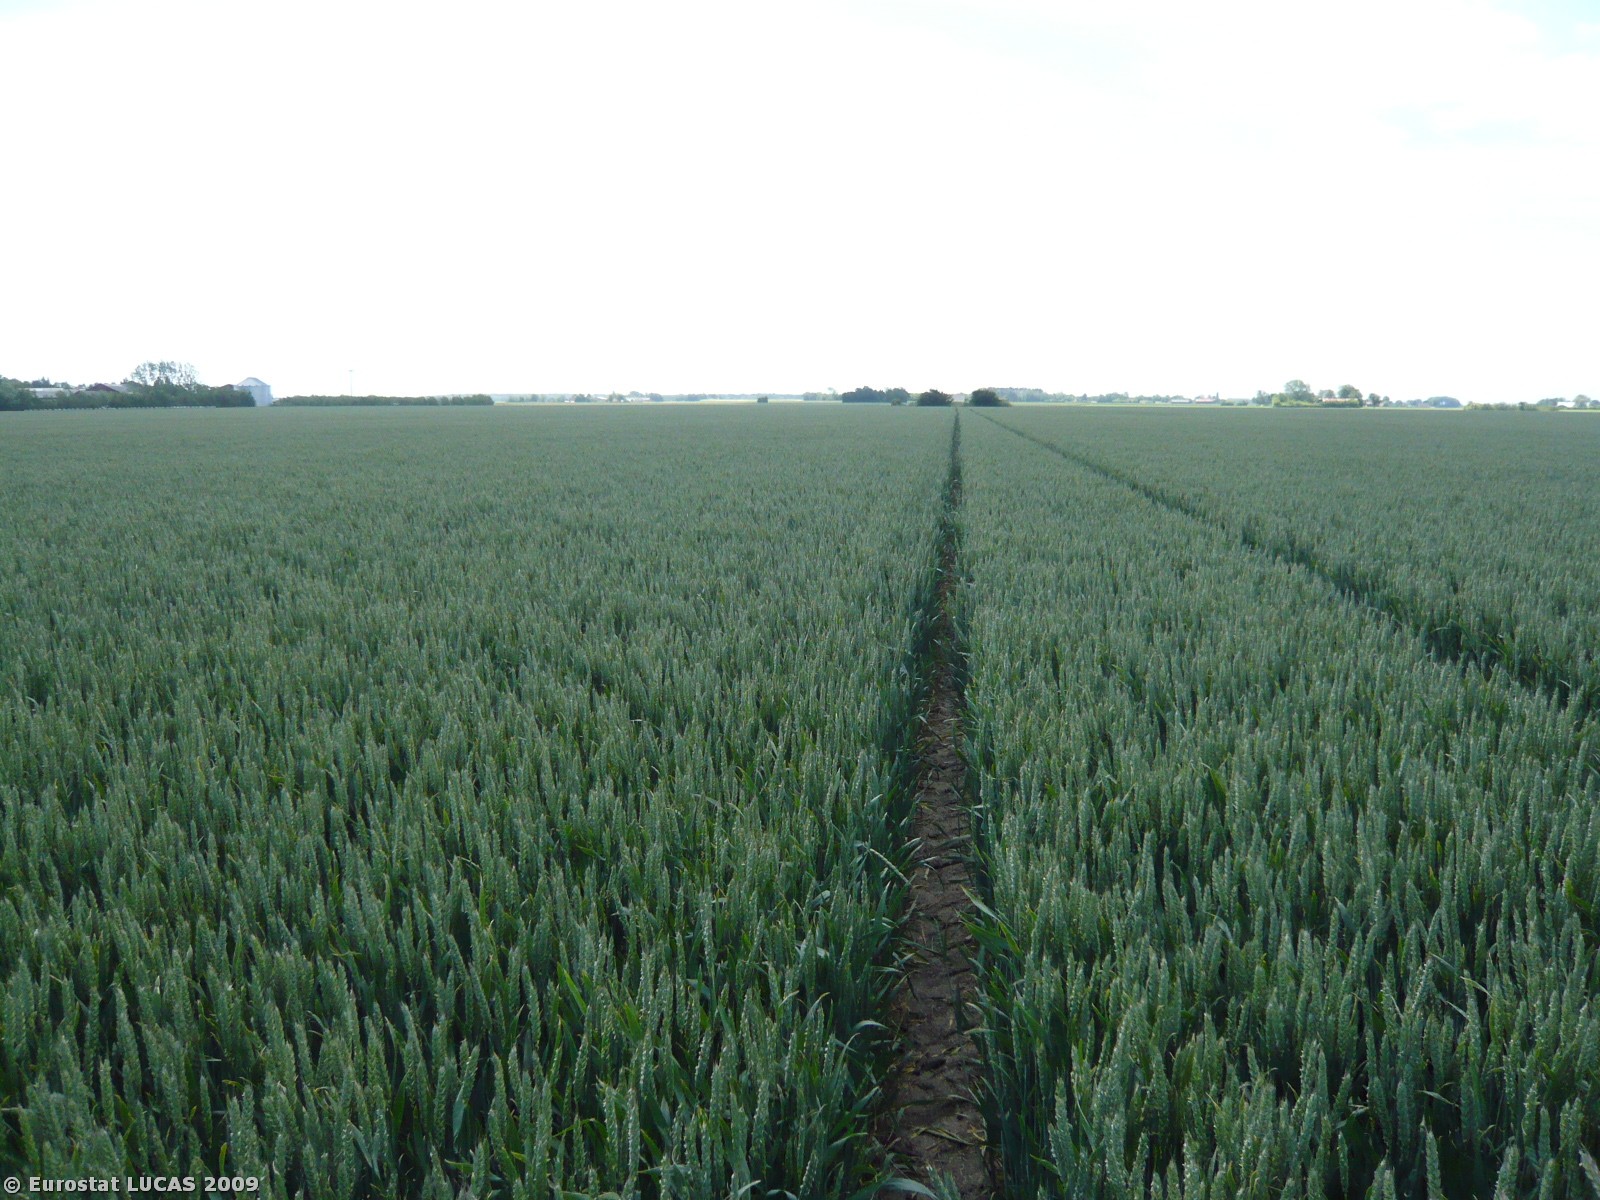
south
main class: Cropland
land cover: Common wheat
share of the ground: > 75 %
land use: Agriculture (excluding fallow land and kitchen gardens)
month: June
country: DK
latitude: 54.7809
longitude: 11.1031
